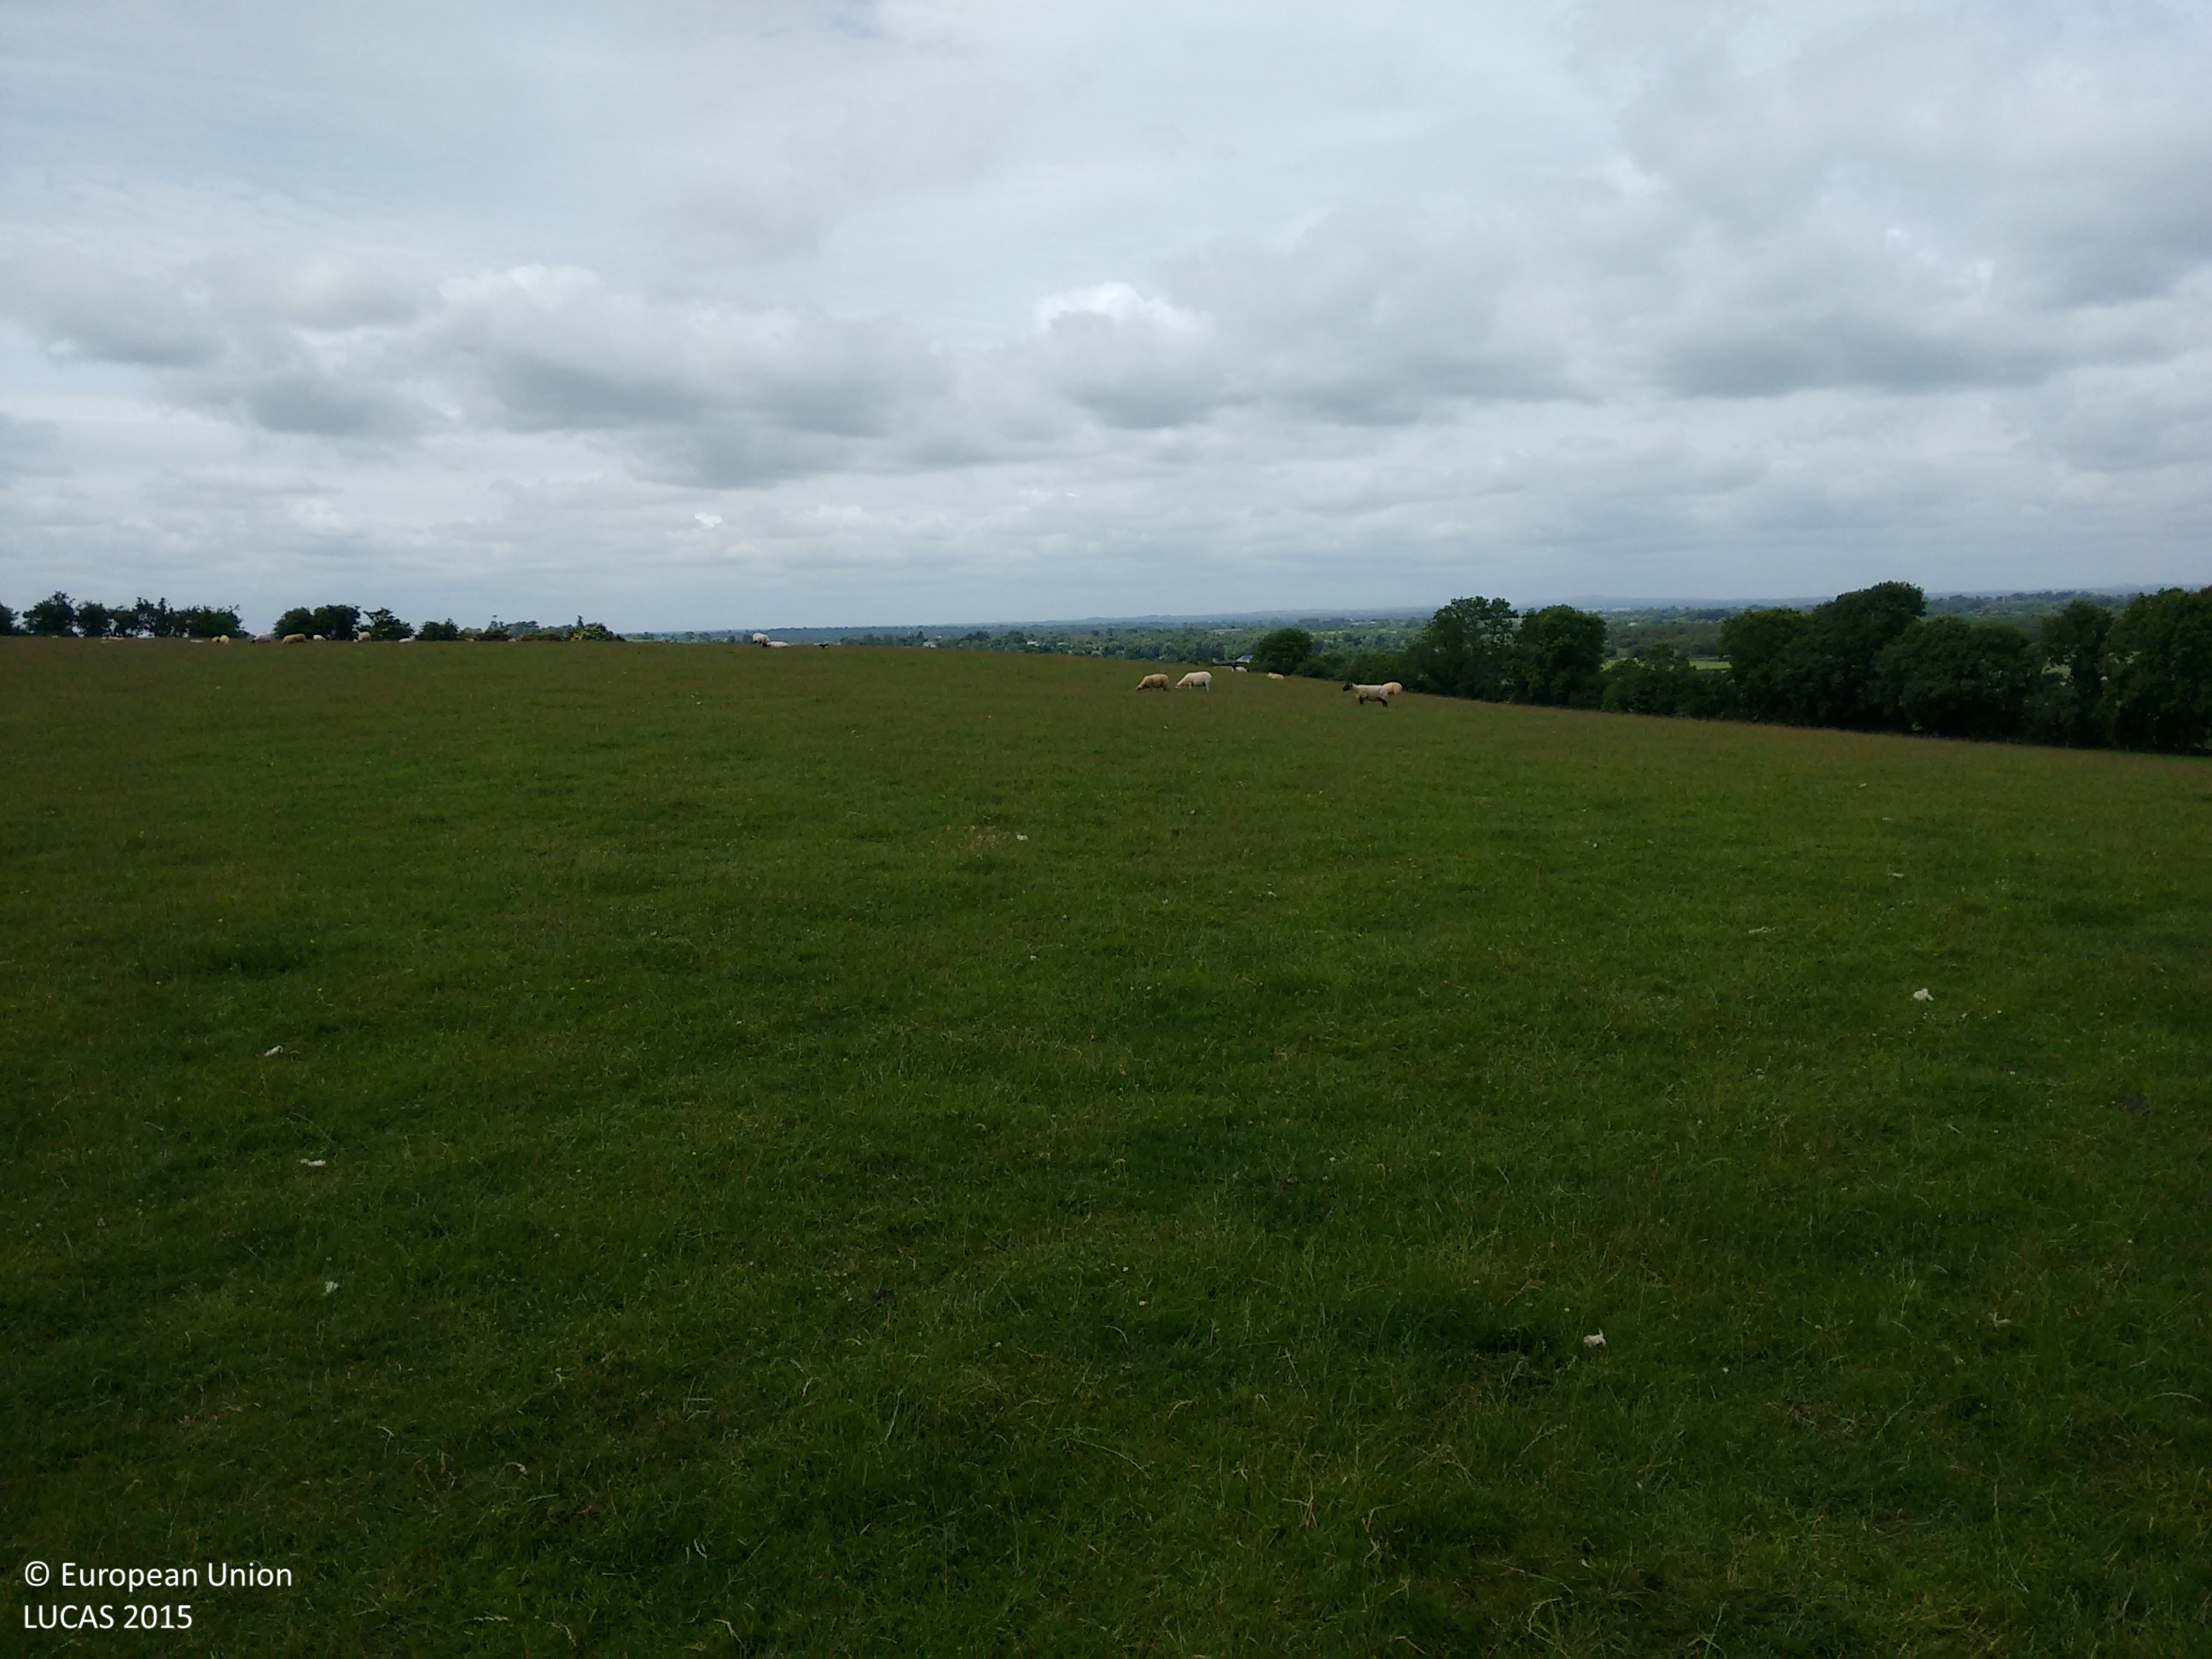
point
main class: Grassland
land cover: Grassland without tree/shrub cover
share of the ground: > 75 %
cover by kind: herbaceous plants 100 %
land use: Agriculture (excluding fallow land and kitchen gardens)
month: June
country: IE
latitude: 53.7418
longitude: -6.6730
